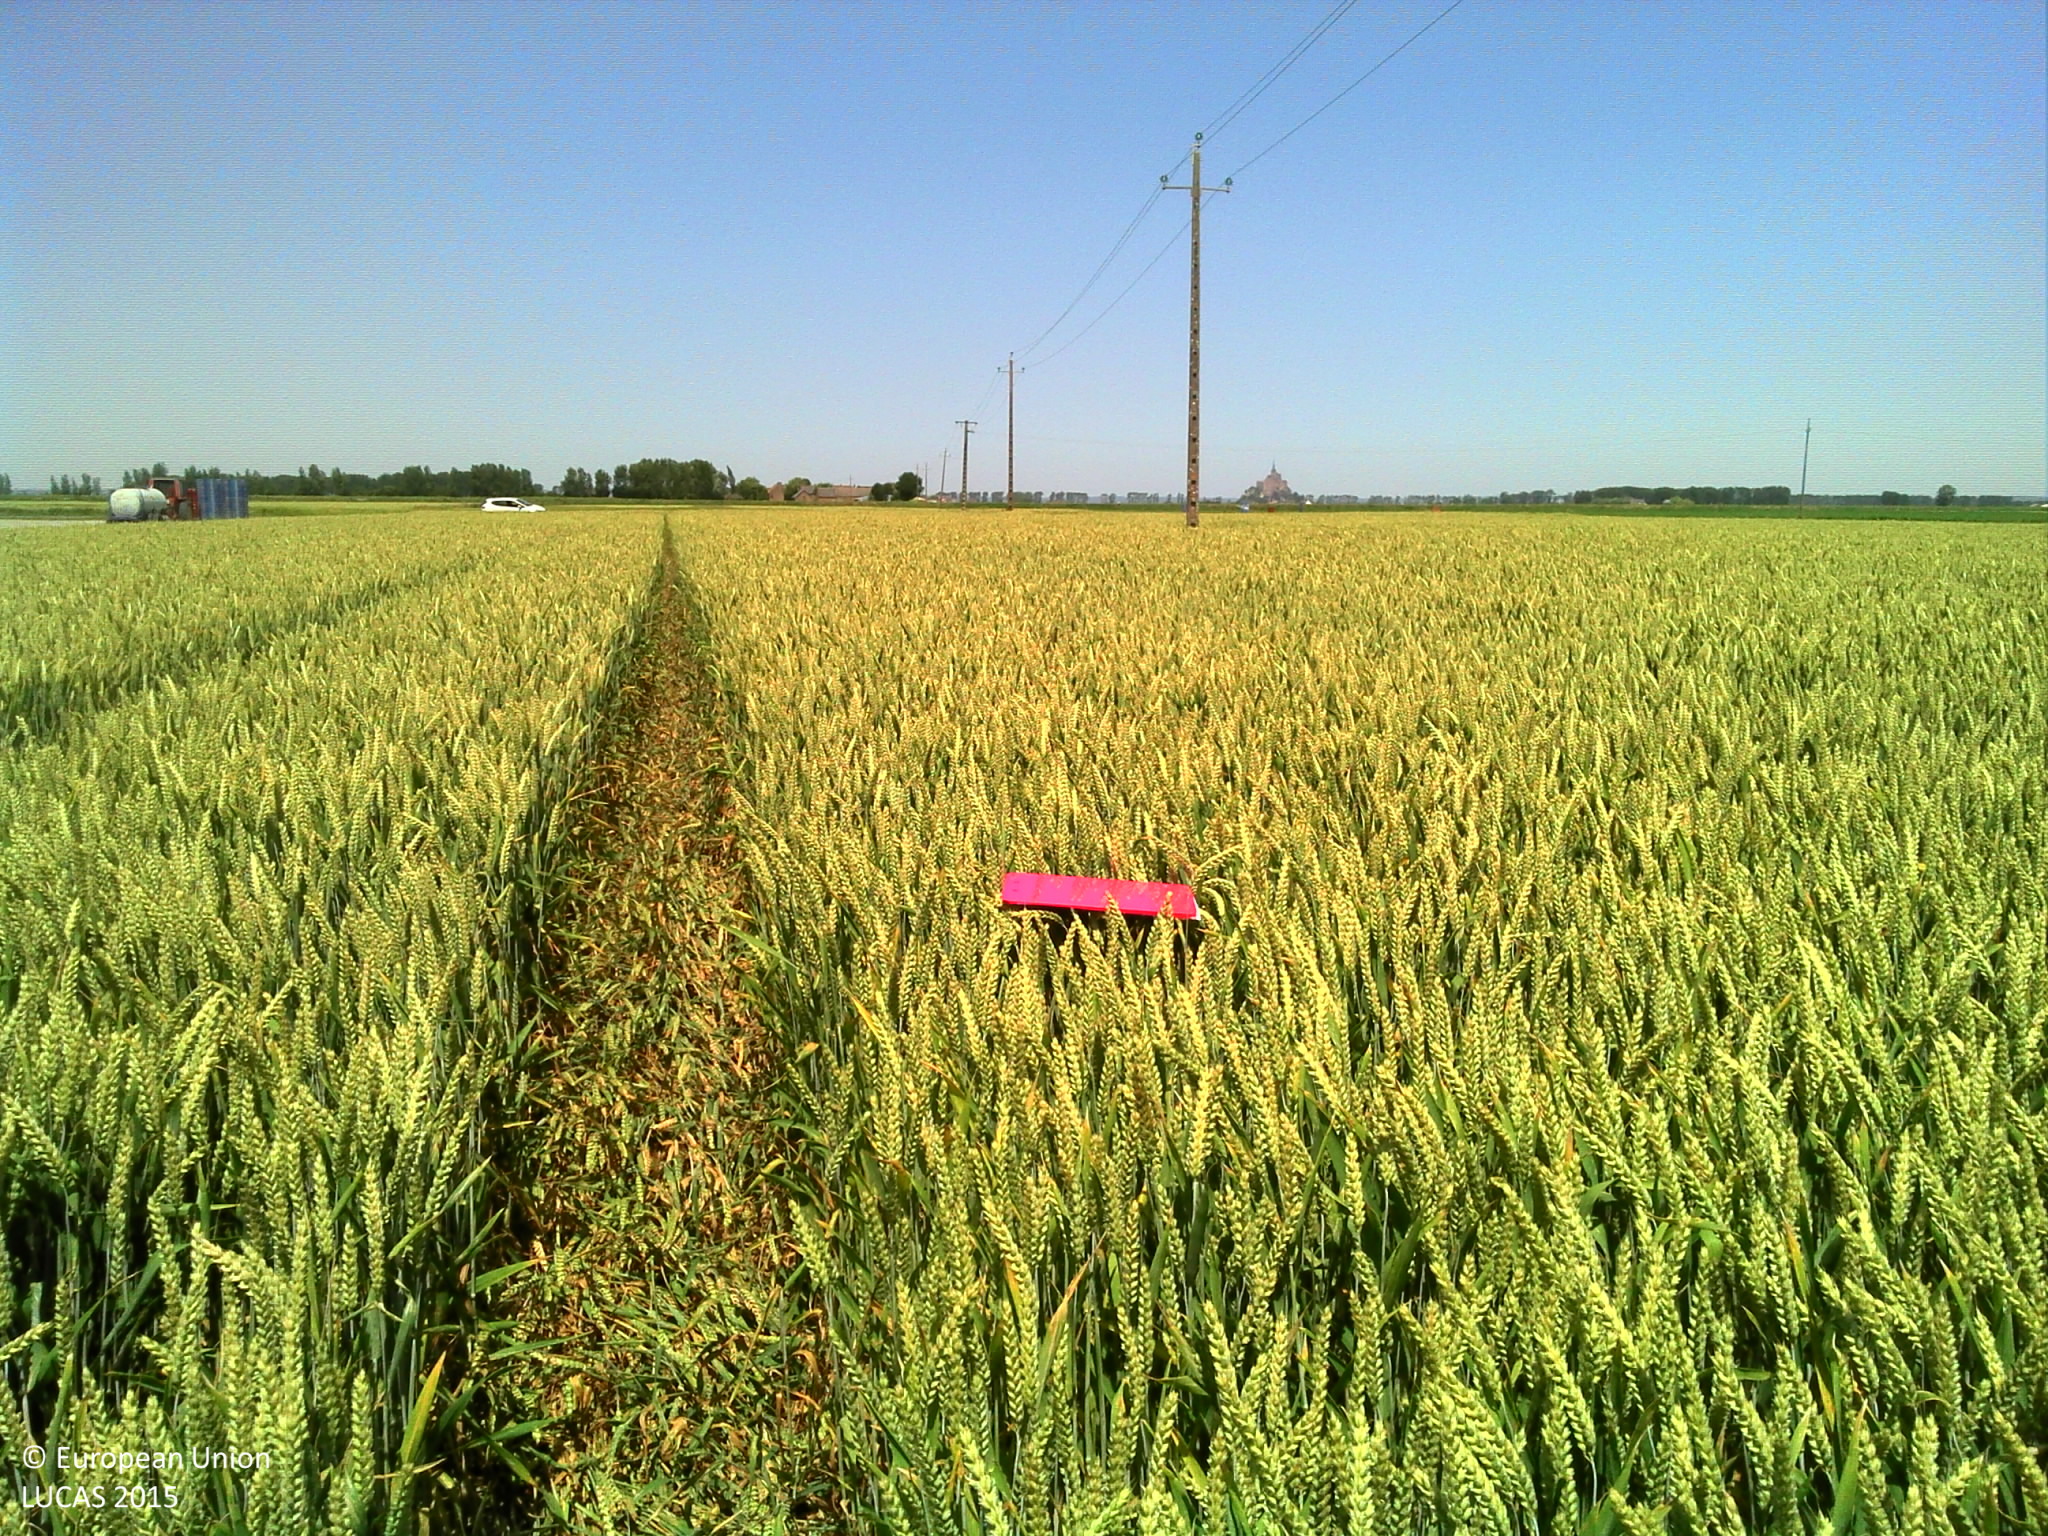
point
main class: Cropland
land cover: Common wheat
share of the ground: > 75 %
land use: Agriculture (excluding fallow land and kitchen gardens)
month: June
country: FR
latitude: 48.5946
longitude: -1.5597
